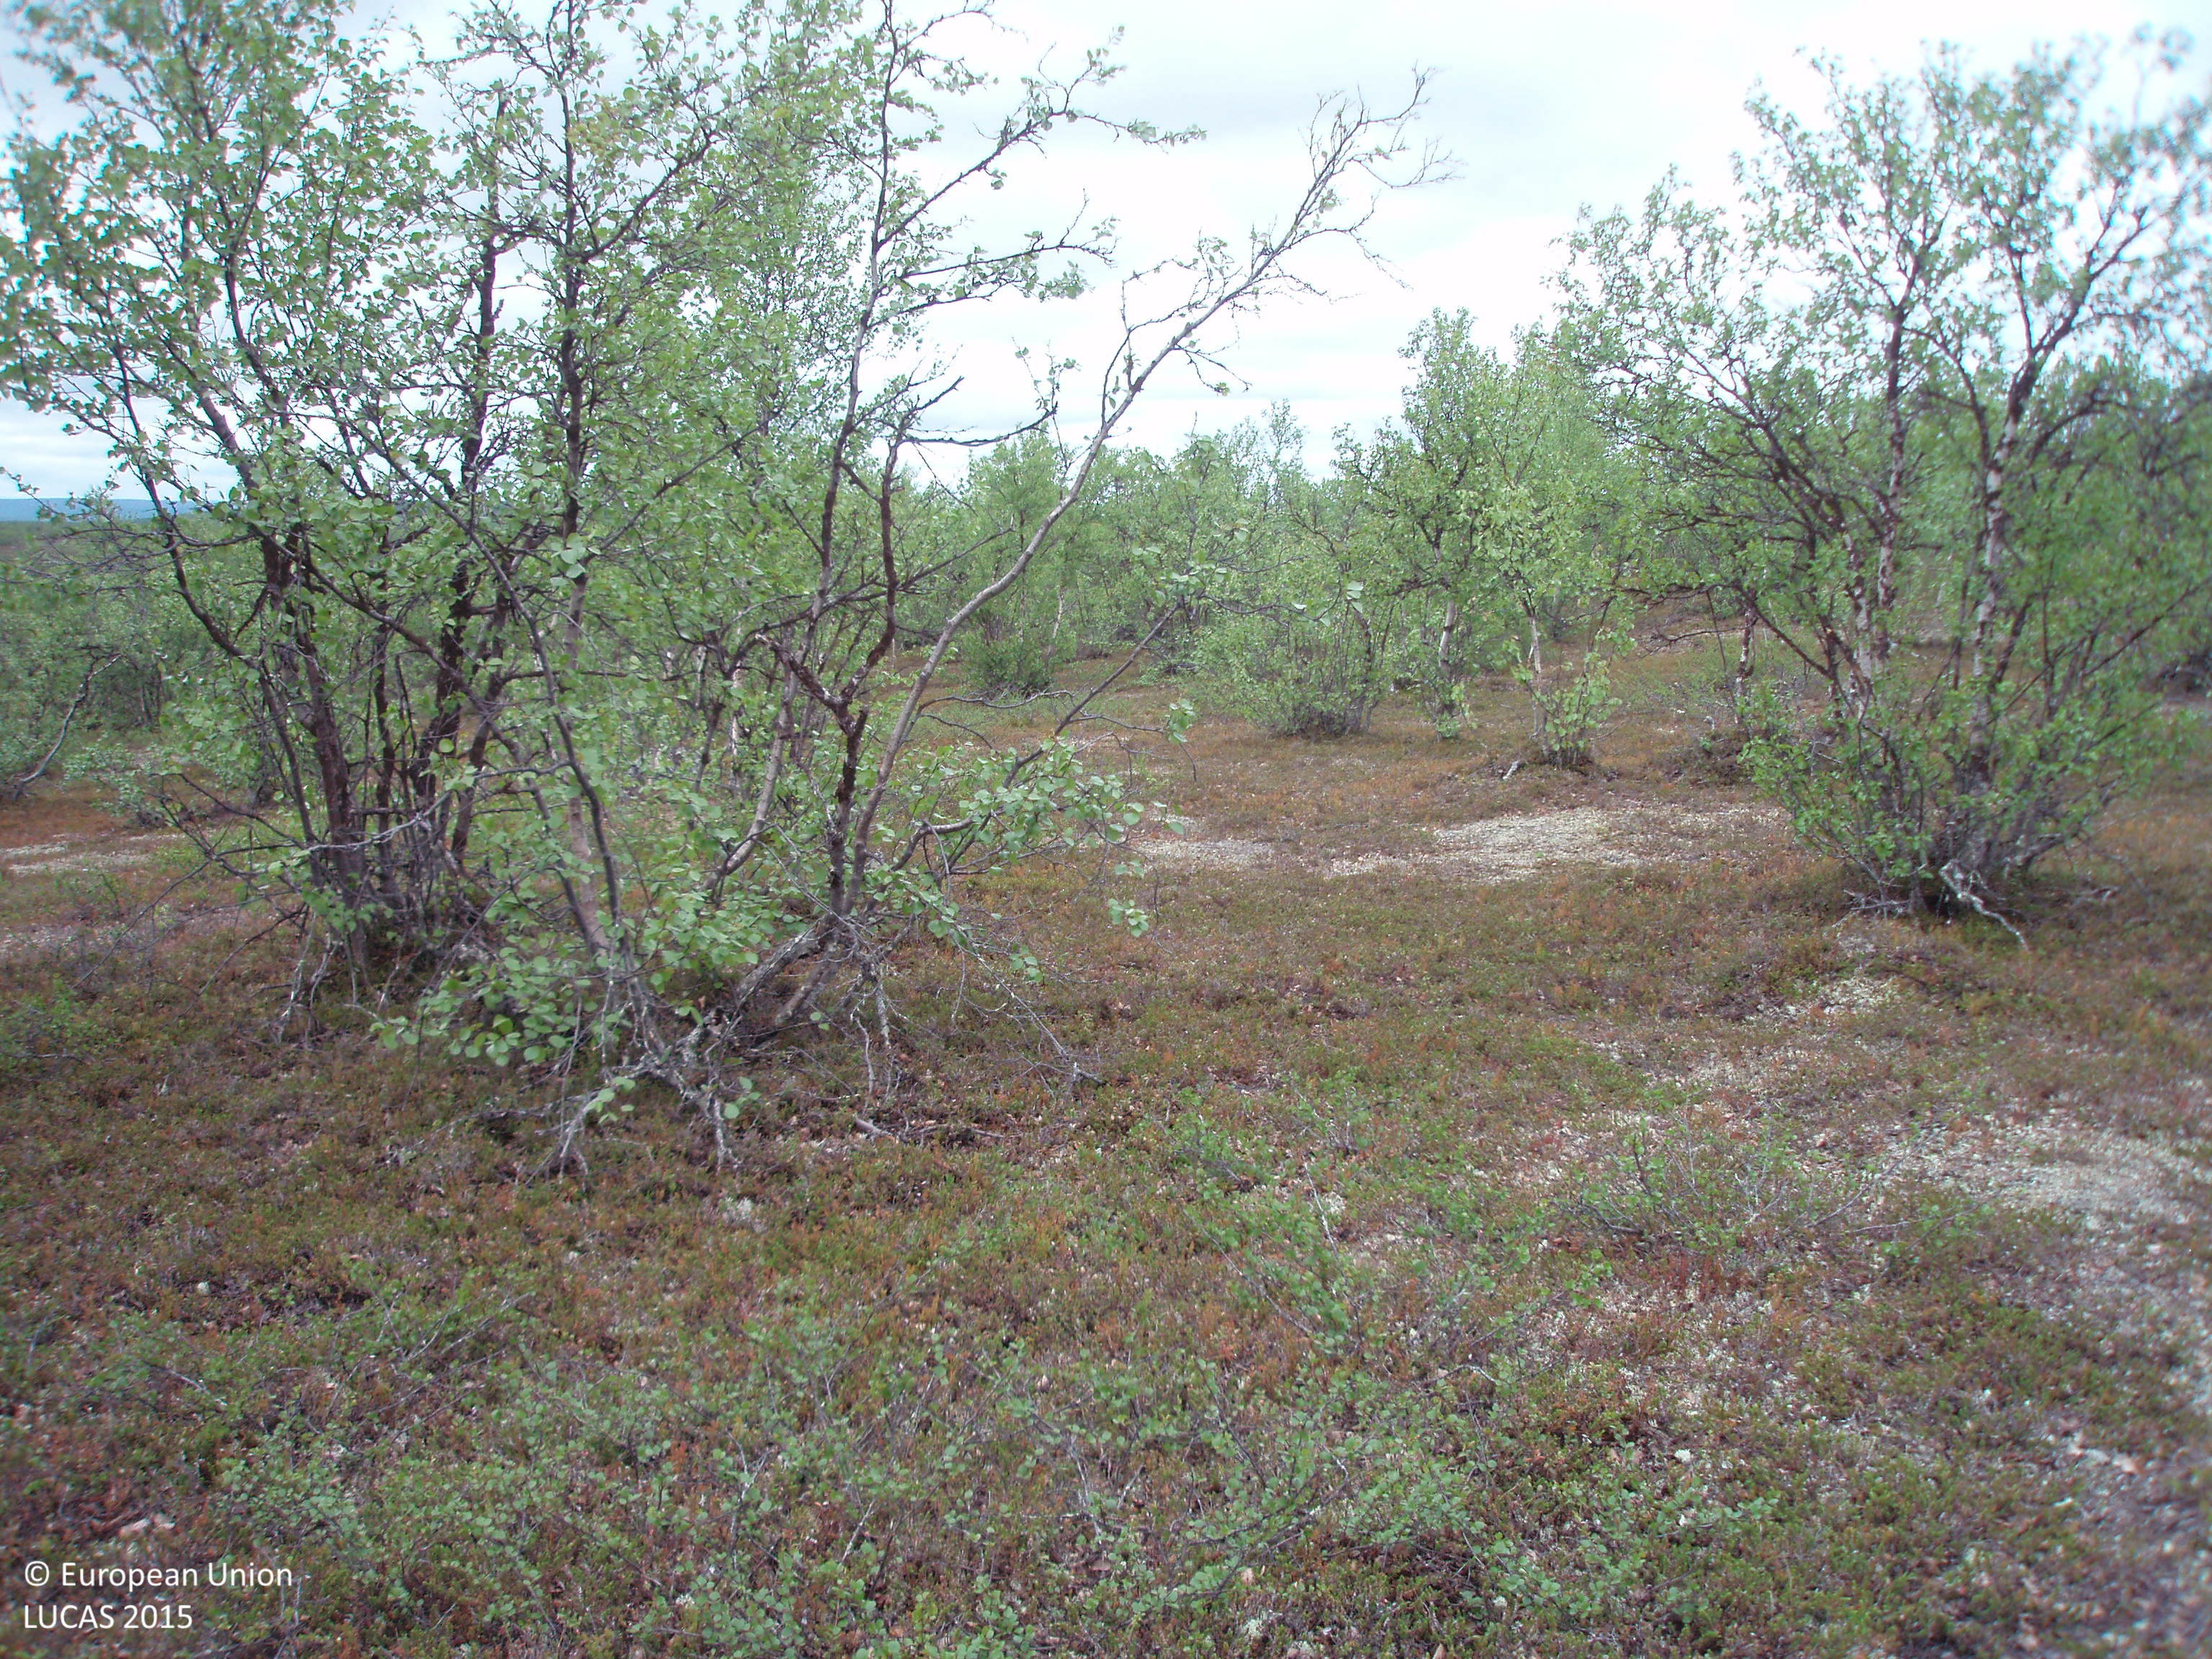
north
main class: Woodland
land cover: Broadleaved woodland
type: boreal forest
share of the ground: 50 - 75 %
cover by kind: broadleaved forest trees 60 %, shrubs 35 %, lichens and mosses 5 %
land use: Semi-natural and natural areas not in use
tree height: > 5 m
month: July
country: FI
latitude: 69.4700
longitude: 27.2504
